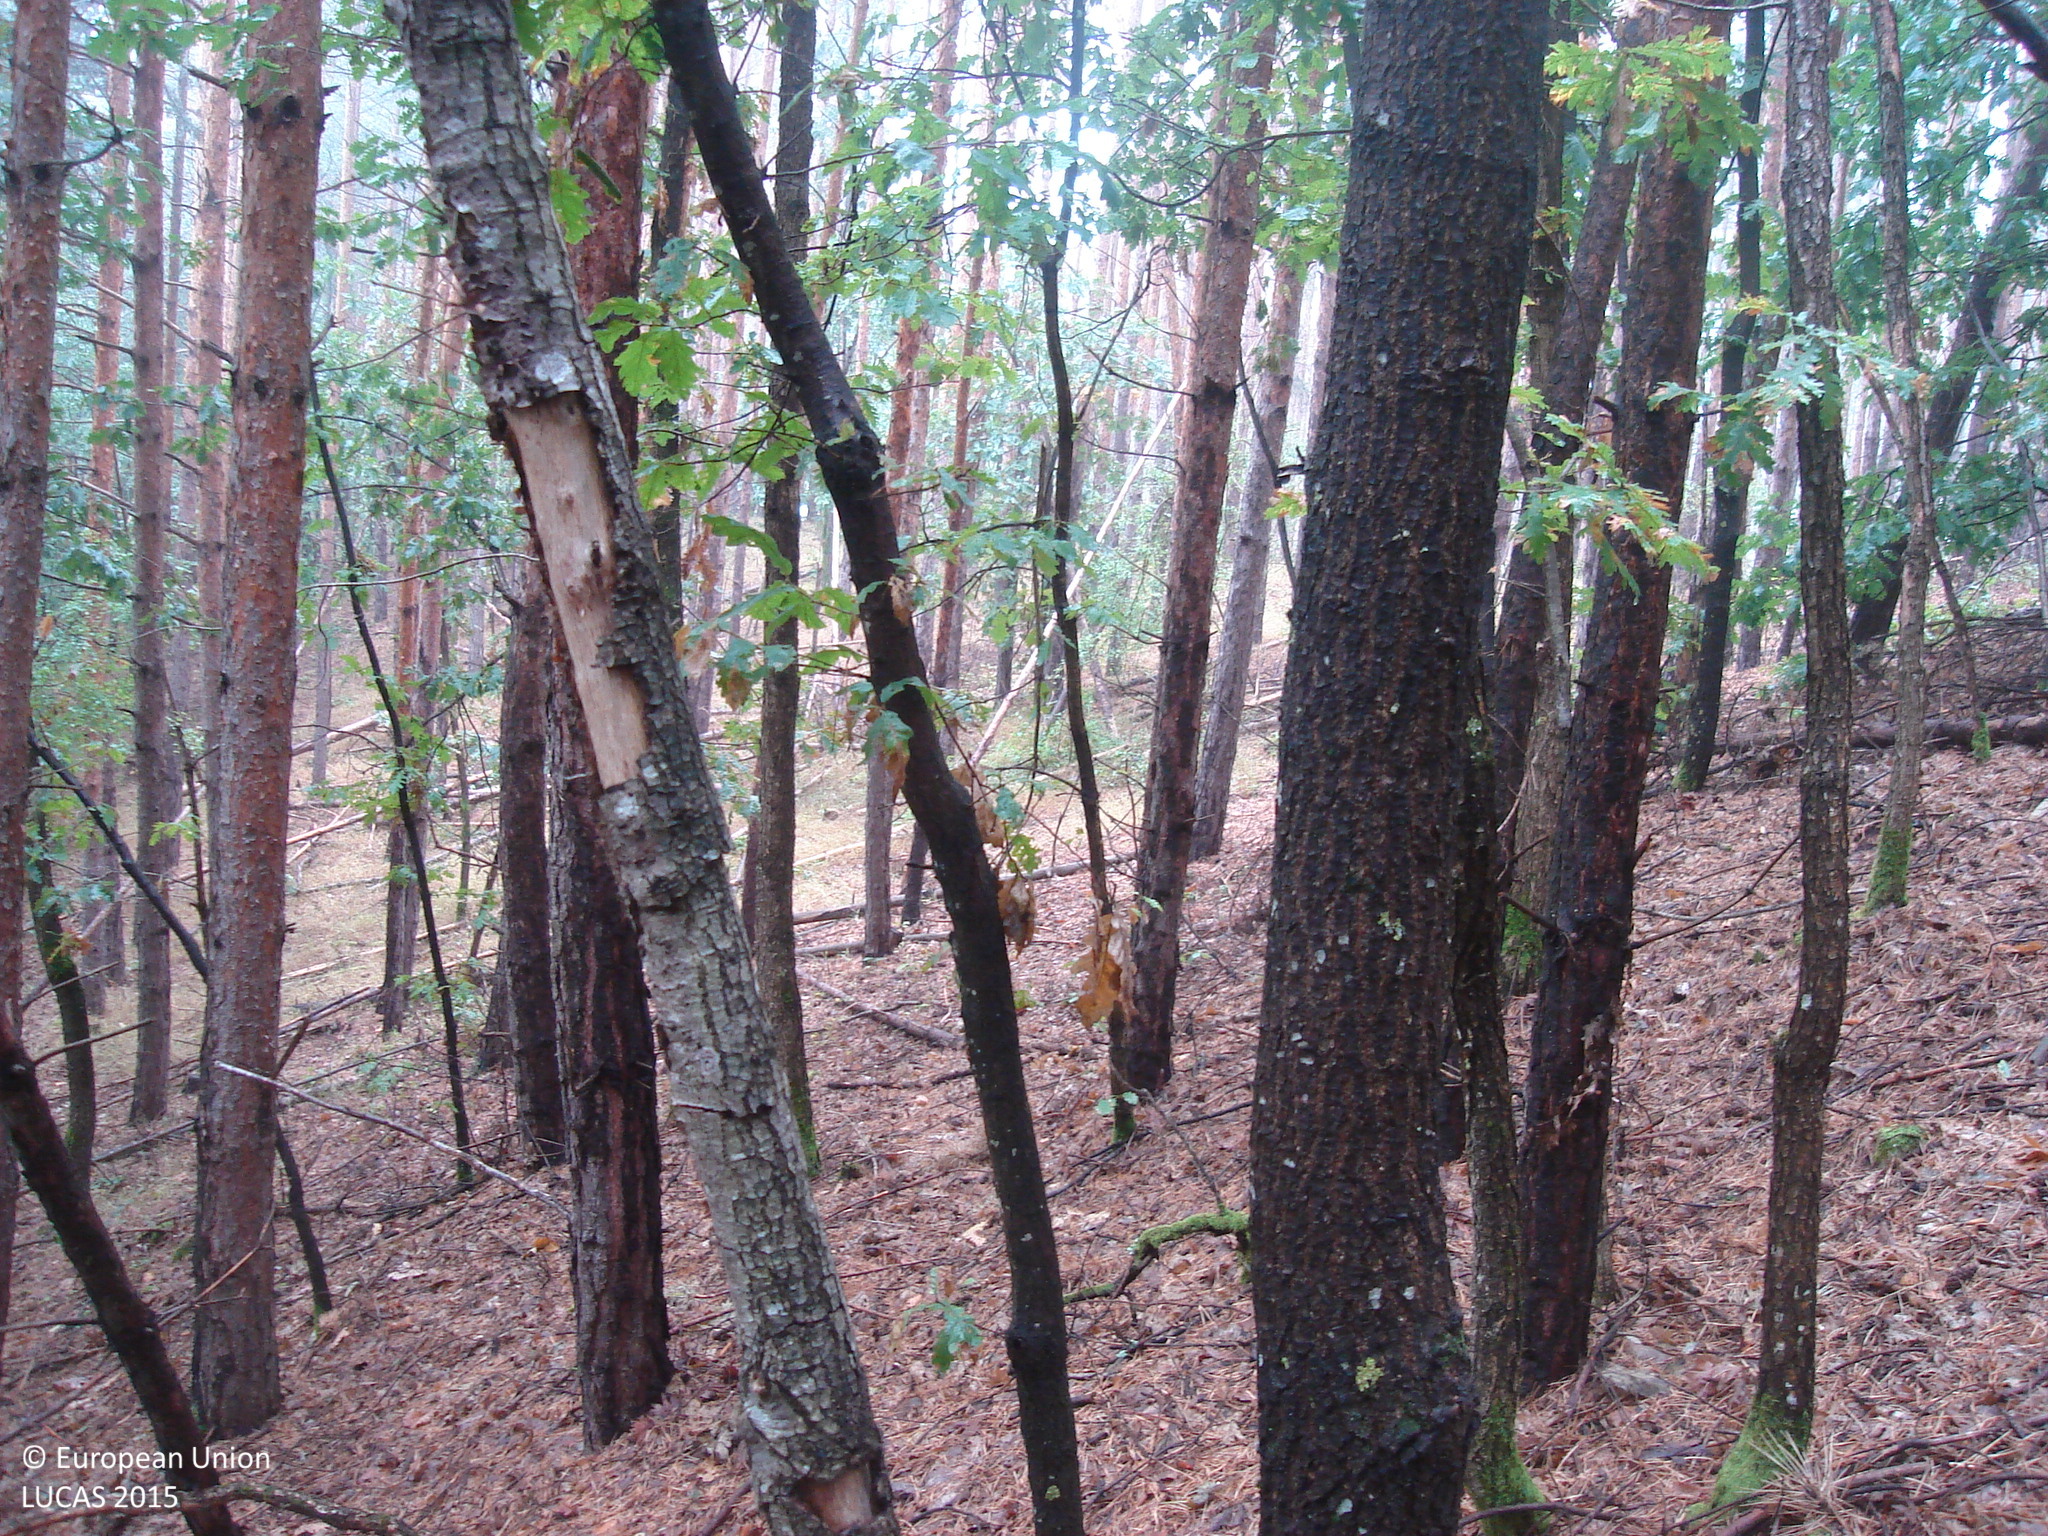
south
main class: Woodland
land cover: Pine dominated mixed woodland
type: hemiboreal forest and nemoral coniferous forest and mixed broadleaved-coniferous forest
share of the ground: > 75 %
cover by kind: coniferous forest trees 50 %, broadleaved forest trees 30 %, unconsolidated bare surface 15 %, herbaceous plants 5 %
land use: Forestry
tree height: > 5 m
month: September
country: BG
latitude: 42.9923
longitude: 23.1959
